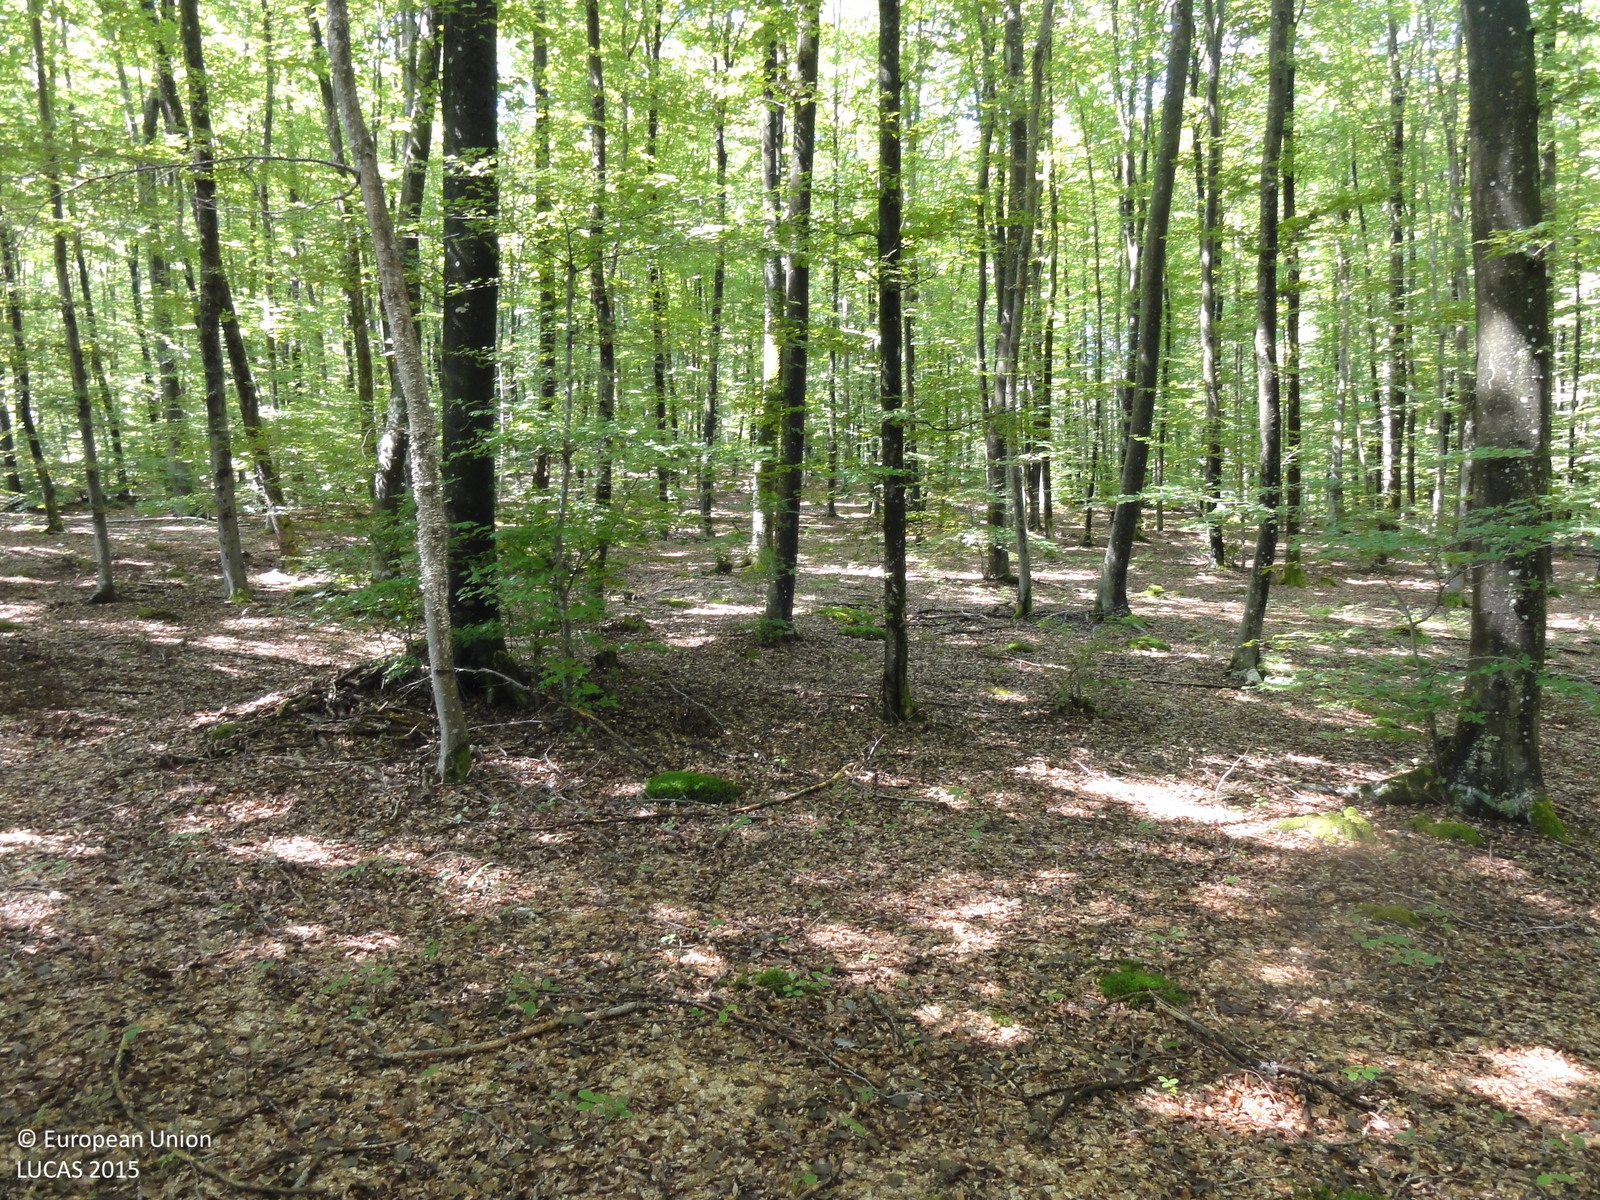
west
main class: Woodland
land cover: Broadleaved woodland
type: beech forest
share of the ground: > 75 %
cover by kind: broadleaved forest trees 100 %
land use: Forestry
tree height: > 5 m
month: August
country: SI
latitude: 46.0068
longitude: 15.2273
